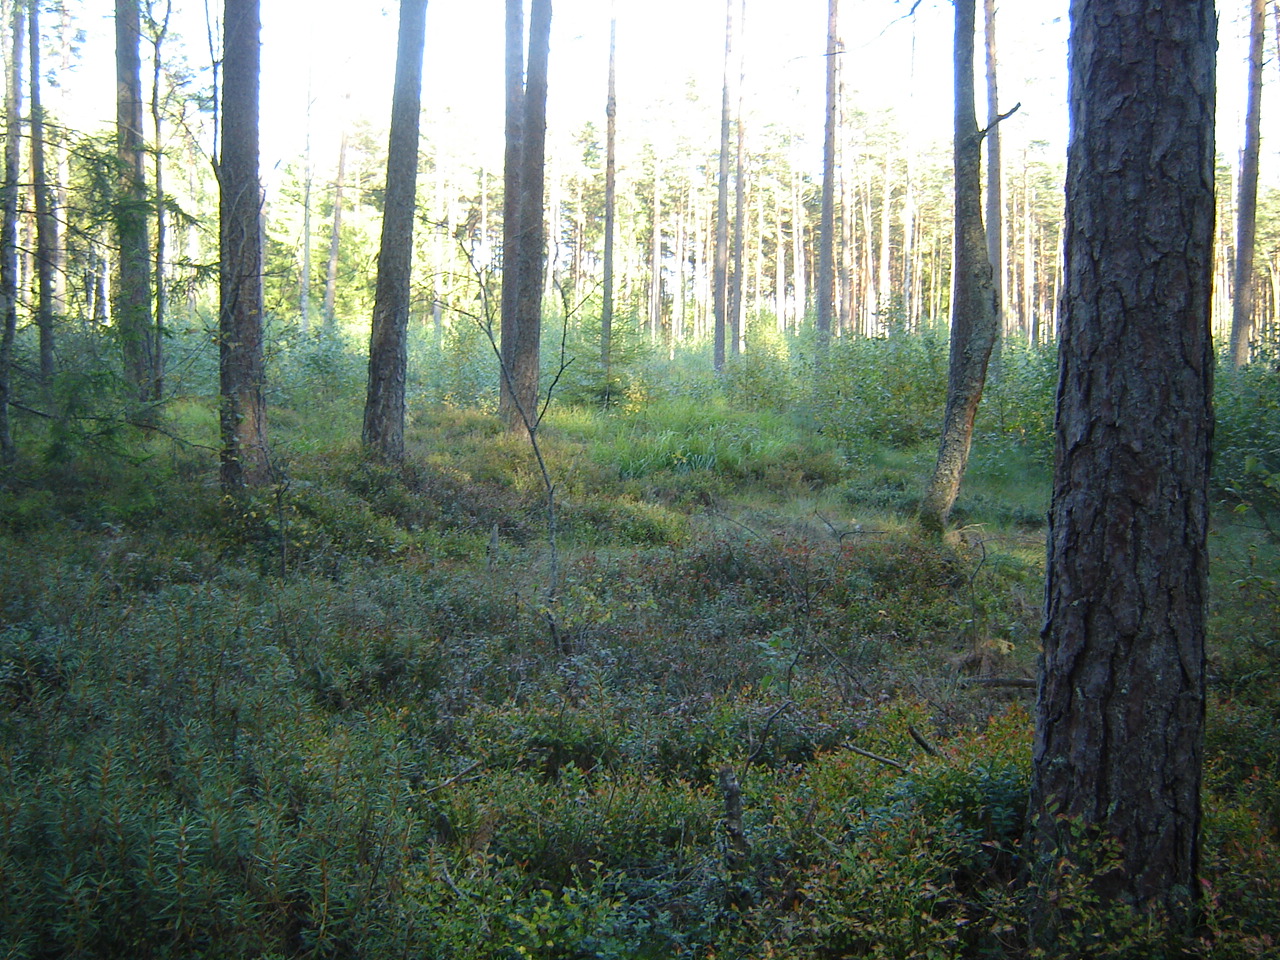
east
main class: Woodland
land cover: Pine dominated coniferous woodland
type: hemiboreal forest and nemoral coniferous forest and mixed broadleaved-coniferous forest
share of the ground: > 75 %
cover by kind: coniferous forest trees 75 %, shrubs 10 %, lichens and mosses 10 %, broadleaved forest trees 5 %
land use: Forestry
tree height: > 5 m
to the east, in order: Pine dominated coniferous woodland; Pine dominated mixed woodland; Pine dominated coniferous woodland; Other structural elements; Pine dominated coniferous woodland; Tracks; Pine dominated coniferous woodland
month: September
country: LT
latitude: 54.3460
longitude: 25.1485
